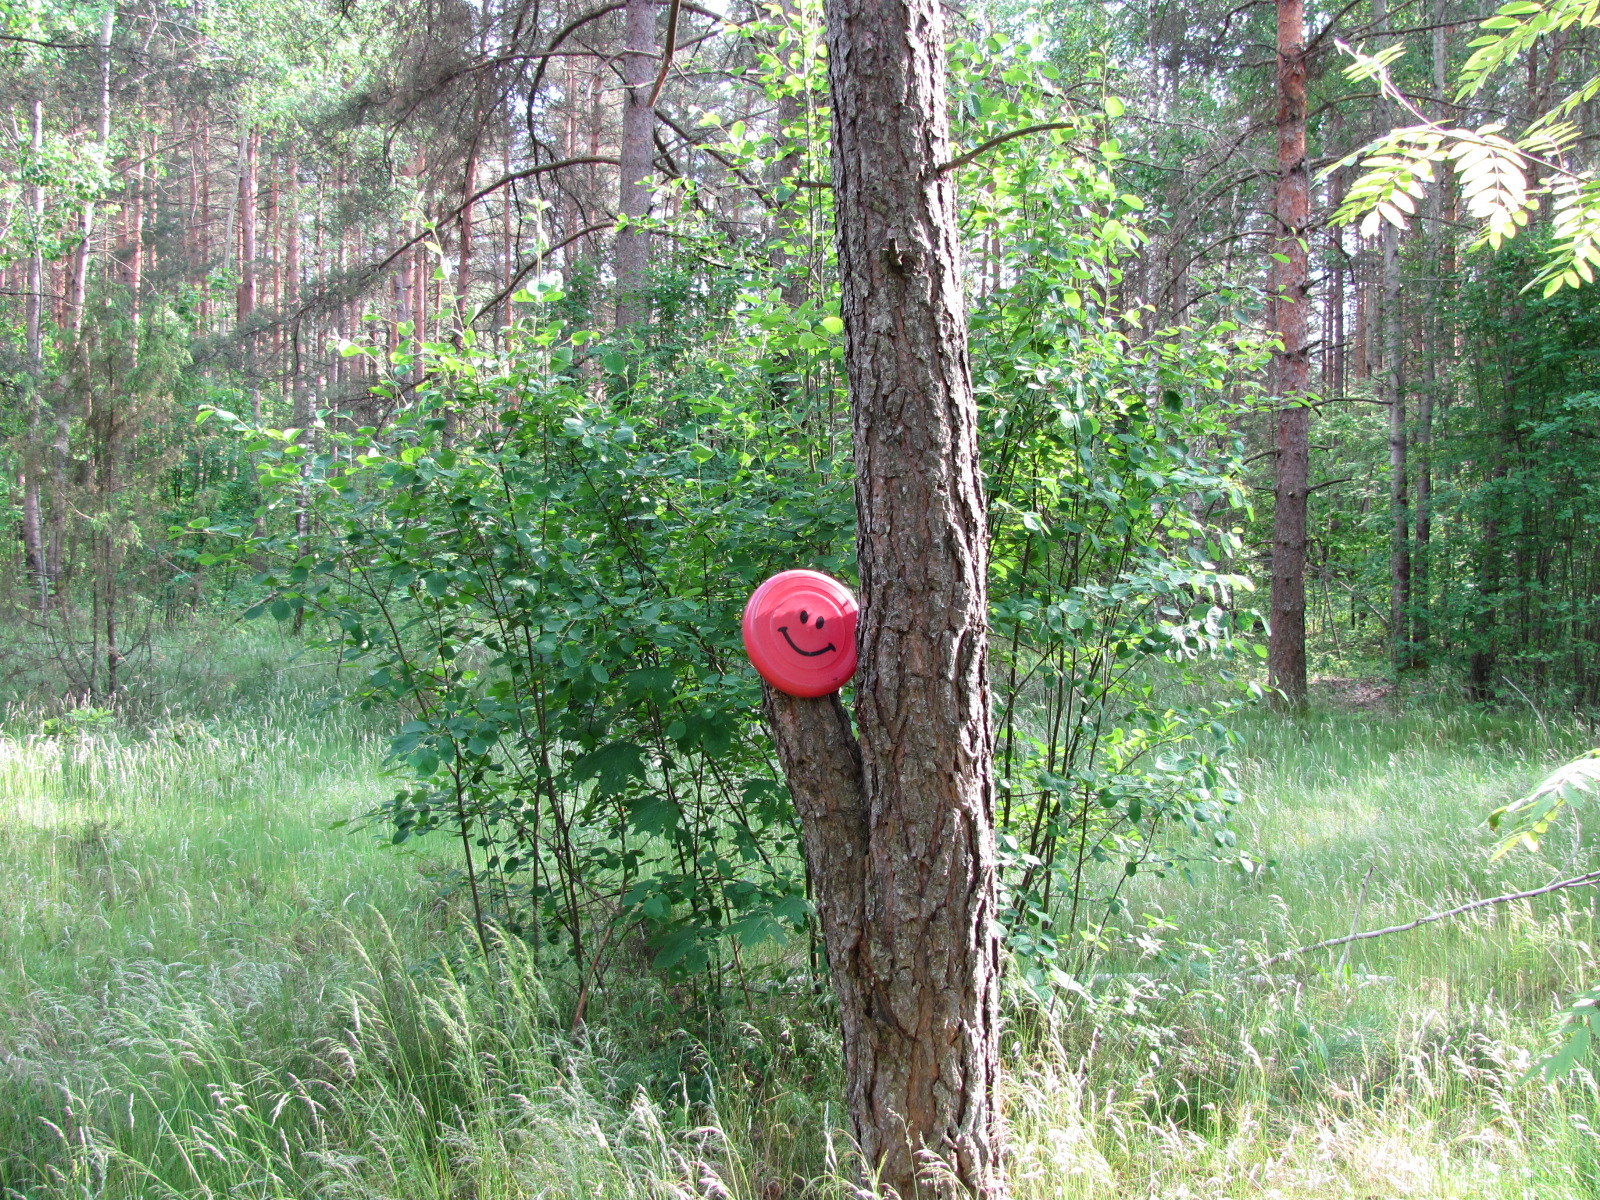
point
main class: Woodland
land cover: Pine dominated coniferous woodland
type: hemiboreal forest and nemoral coniferous forest and mixed broadleaved-coniferous forest
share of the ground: > 75 %
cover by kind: coniferous forest trees 75 %, herbaceous plants 25 %
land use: Forestry
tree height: > 5 m
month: June
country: LV
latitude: 56.9394
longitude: 24.2732
